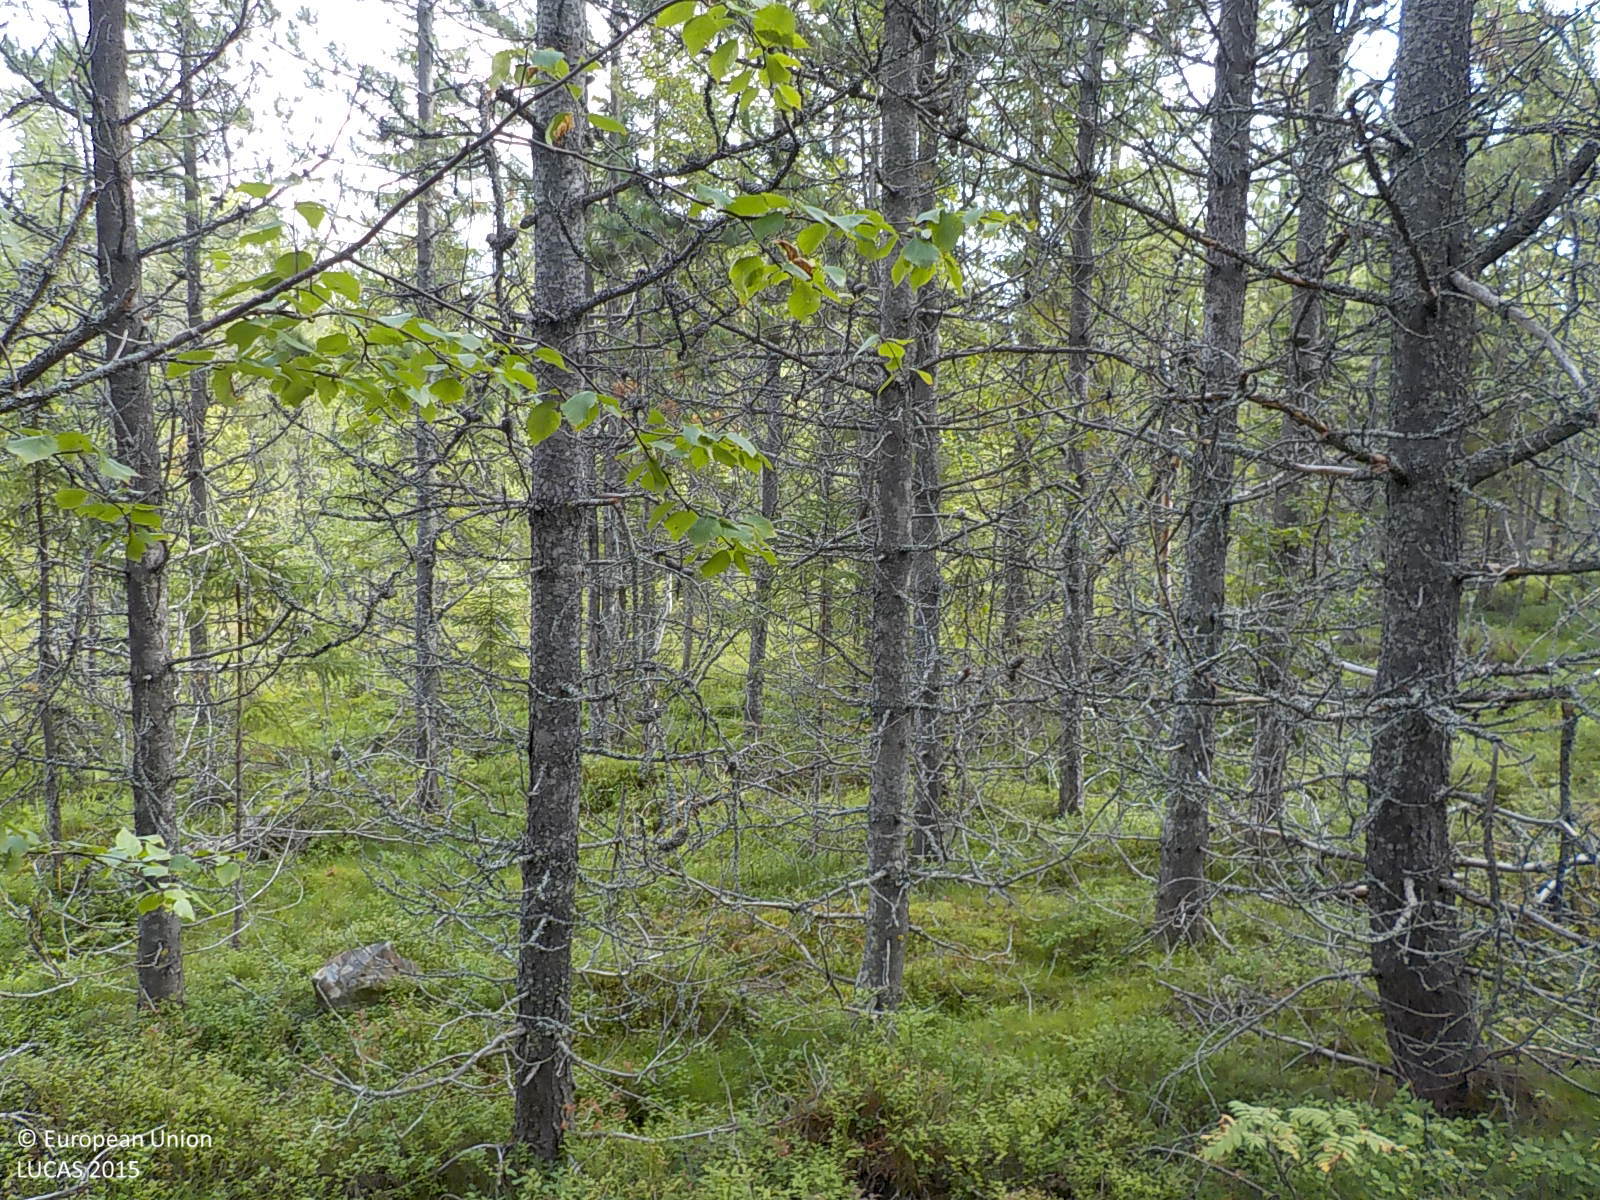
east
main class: Woodland
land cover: Pine dominated coniferous woodland
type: exotic forest
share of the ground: > 75 %
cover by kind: coniferous forest trees 85 %, shrubs 15 %
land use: Forestry
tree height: < 5 m
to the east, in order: Pine dominated coniferous woodland; Pine dominated mixed woodland; Spruce dominated mixed woodland
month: September
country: SE
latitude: 63.2740
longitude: 17.9285
